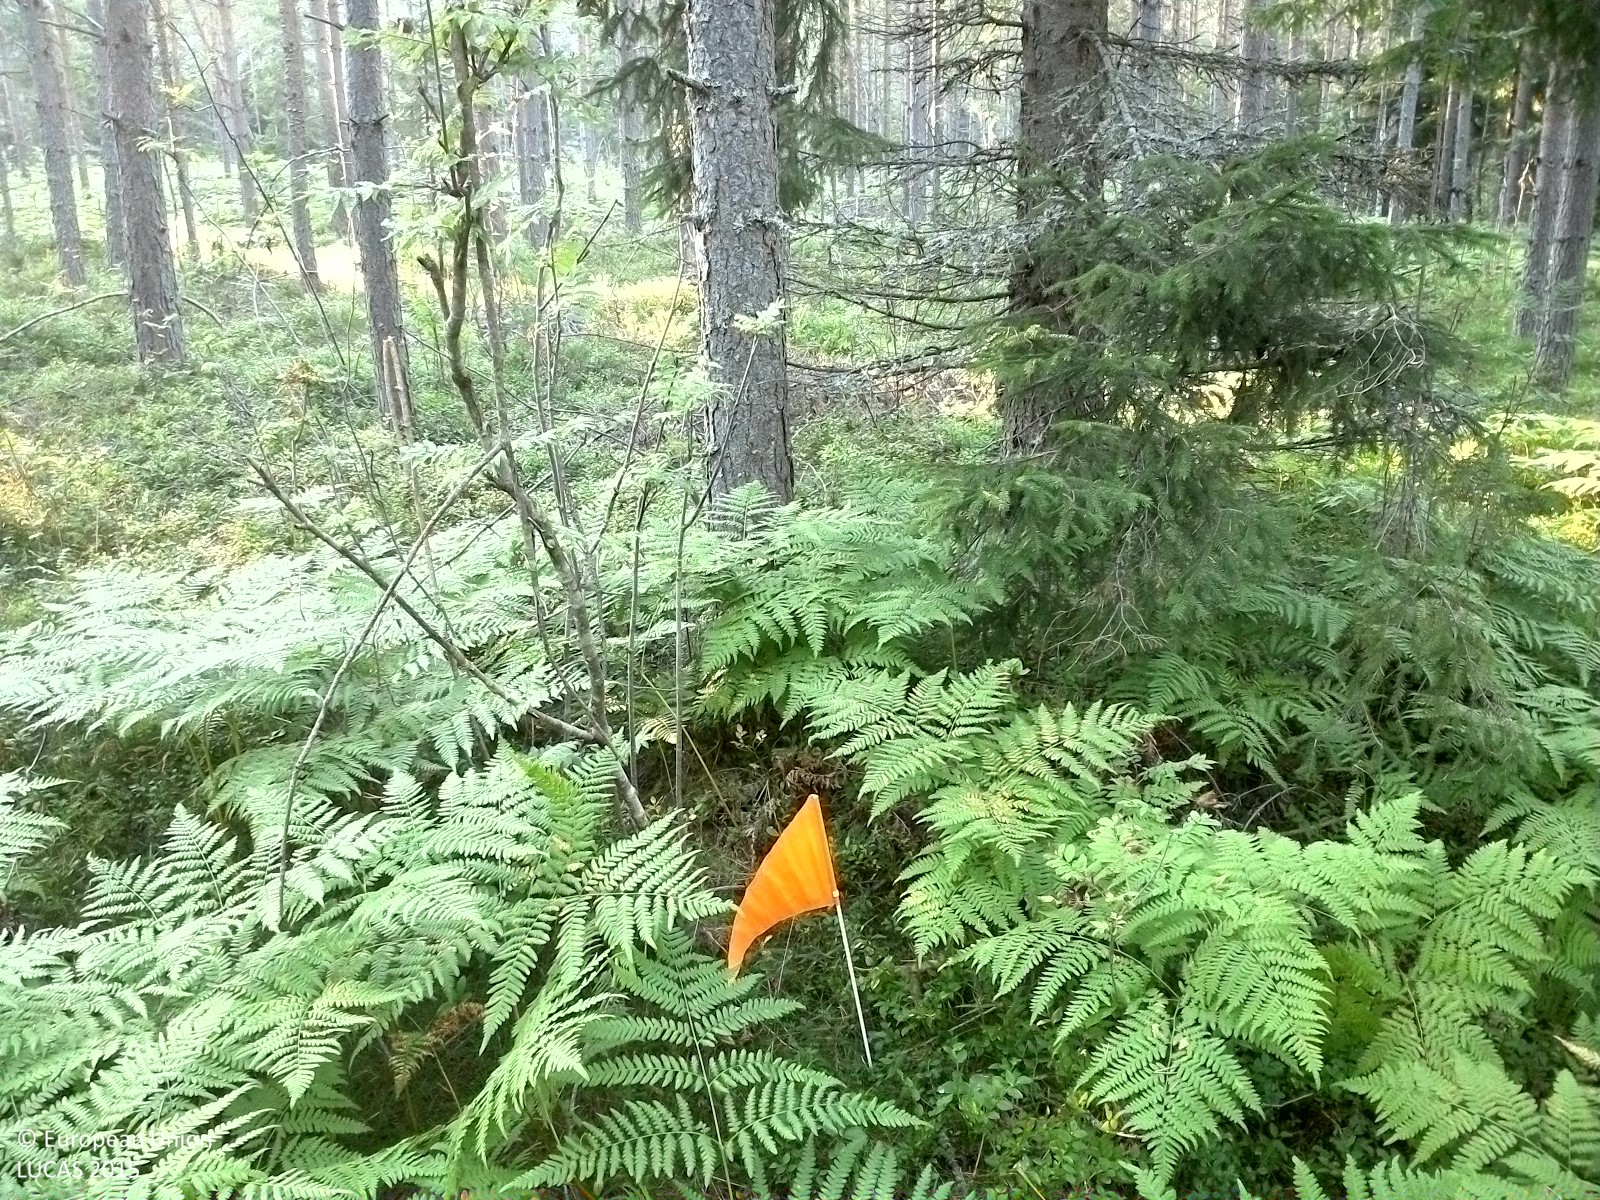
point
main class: Woodland
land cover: Pine dominated coniferous woodland
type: boreal forest
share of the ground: 50 - 75 %
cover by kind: coniferous forest trees 55 %, herbaceous plants 30 %, shrubs 15 %
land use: Forestry
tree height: > 5 m
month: August
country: SE
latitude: 62.5859
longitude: 17.9042
